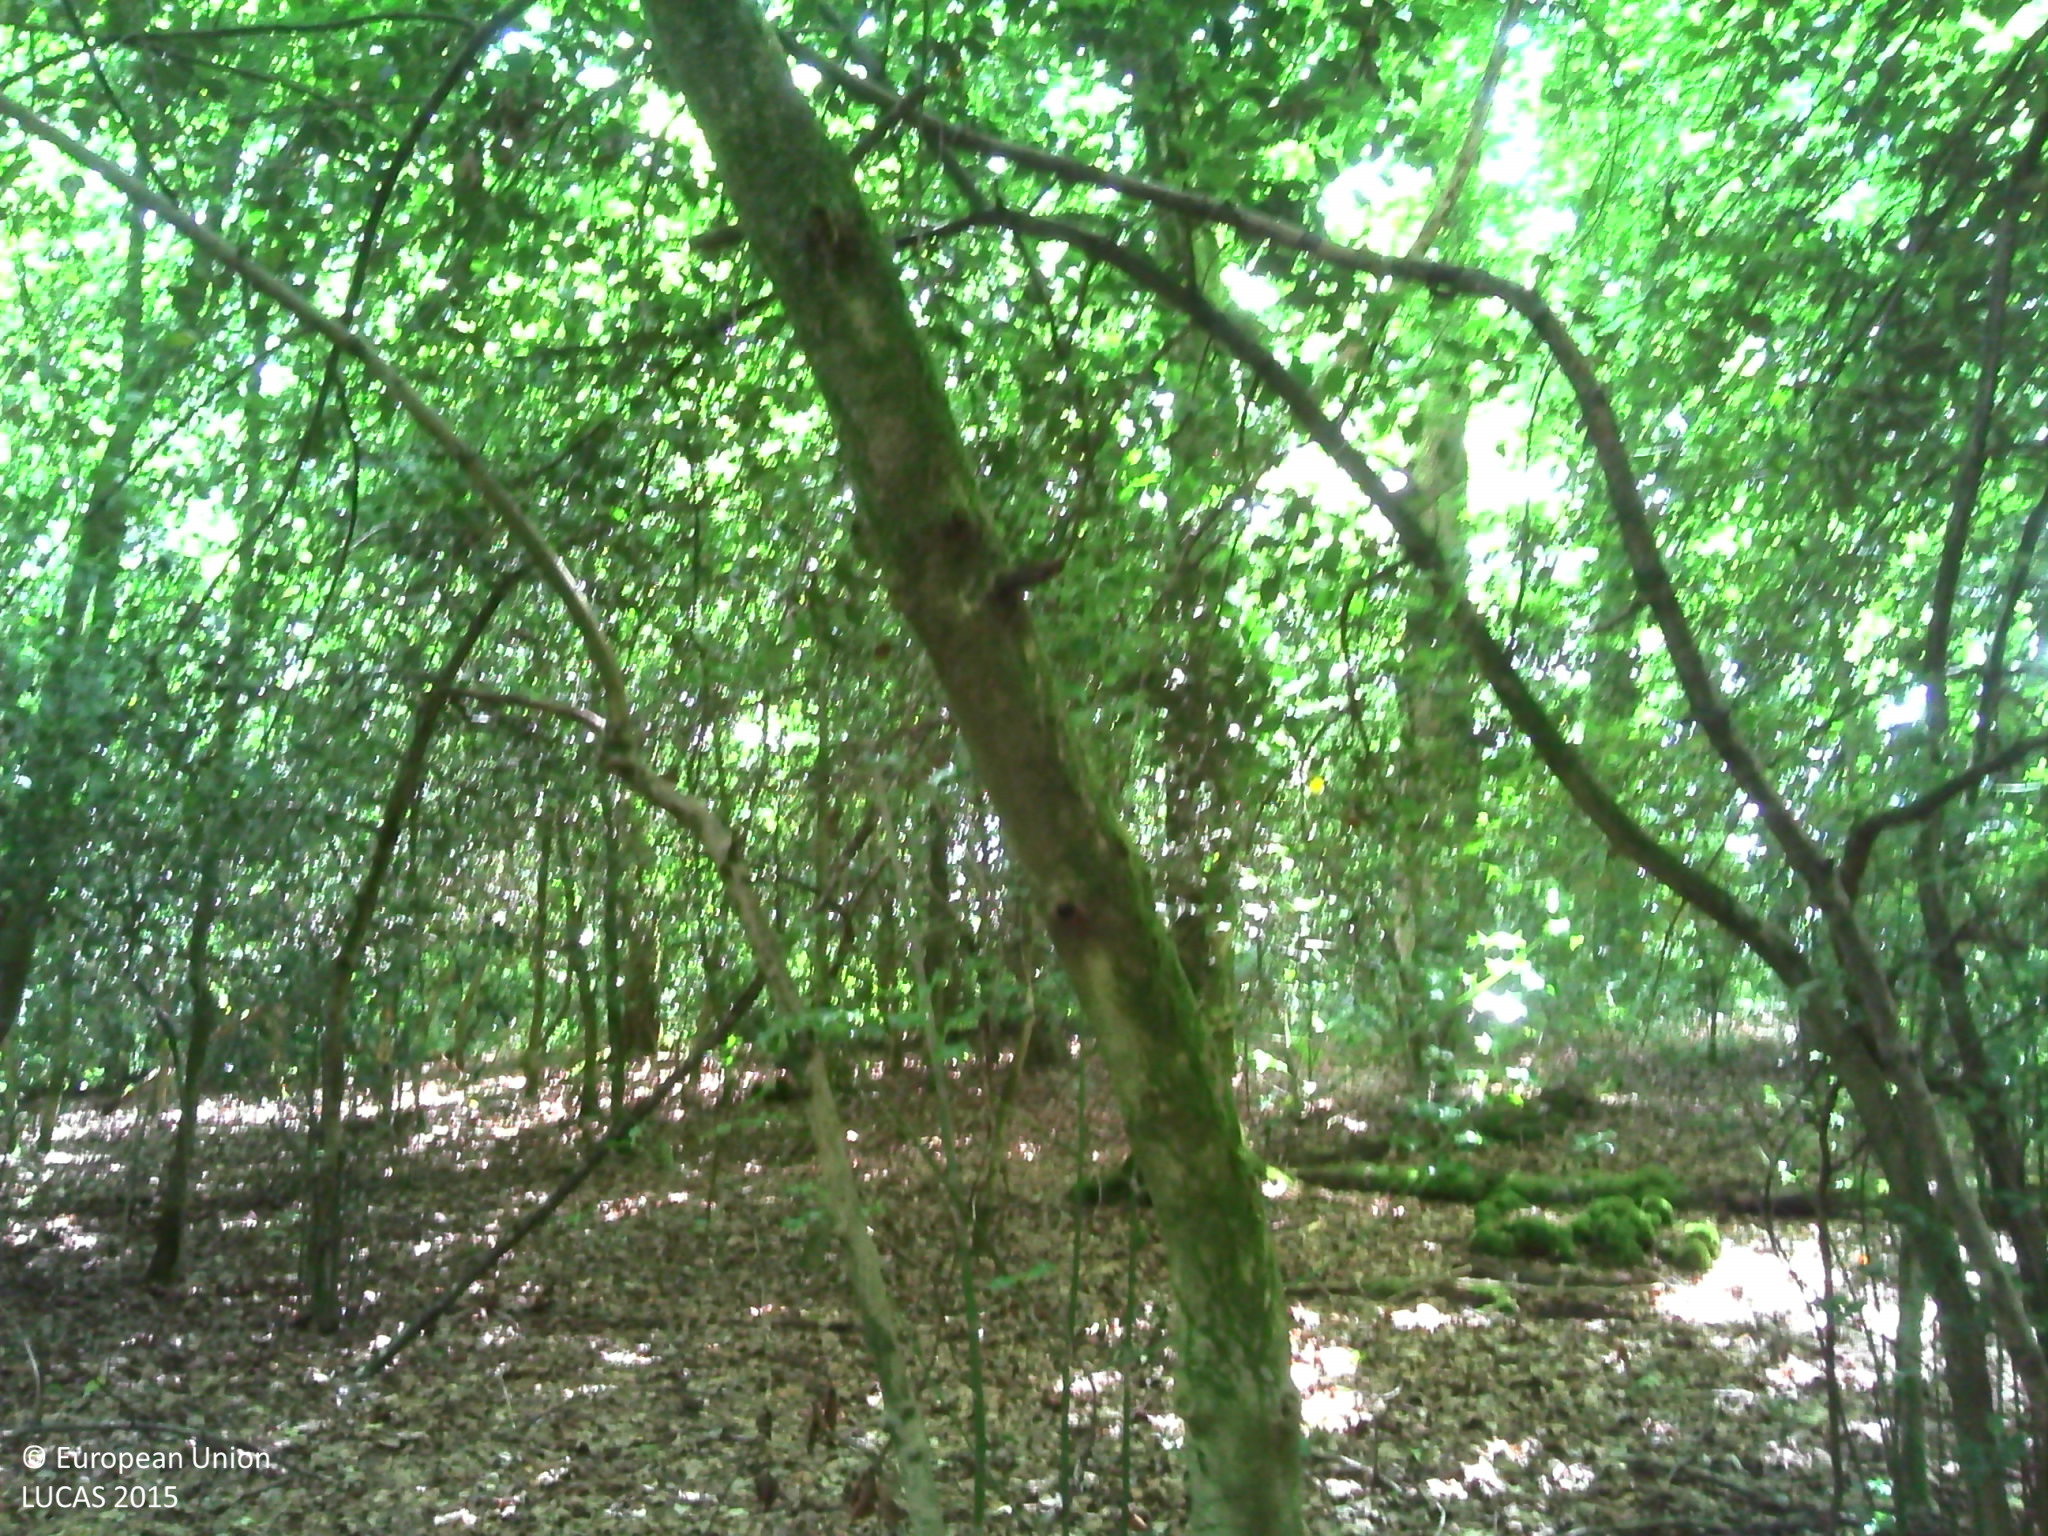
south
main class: Woodland
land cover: Broadleaved woodland
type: acidophilous oak and oak-birch forest
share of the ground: > 75 %
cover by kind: broadleaved forest trees 85 %, herbaceous plants 10 %, lichens and mosses 5 %
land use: Forestry
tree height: > 5 m
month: June
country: FR
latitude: 47.2787
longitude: 3.9037
